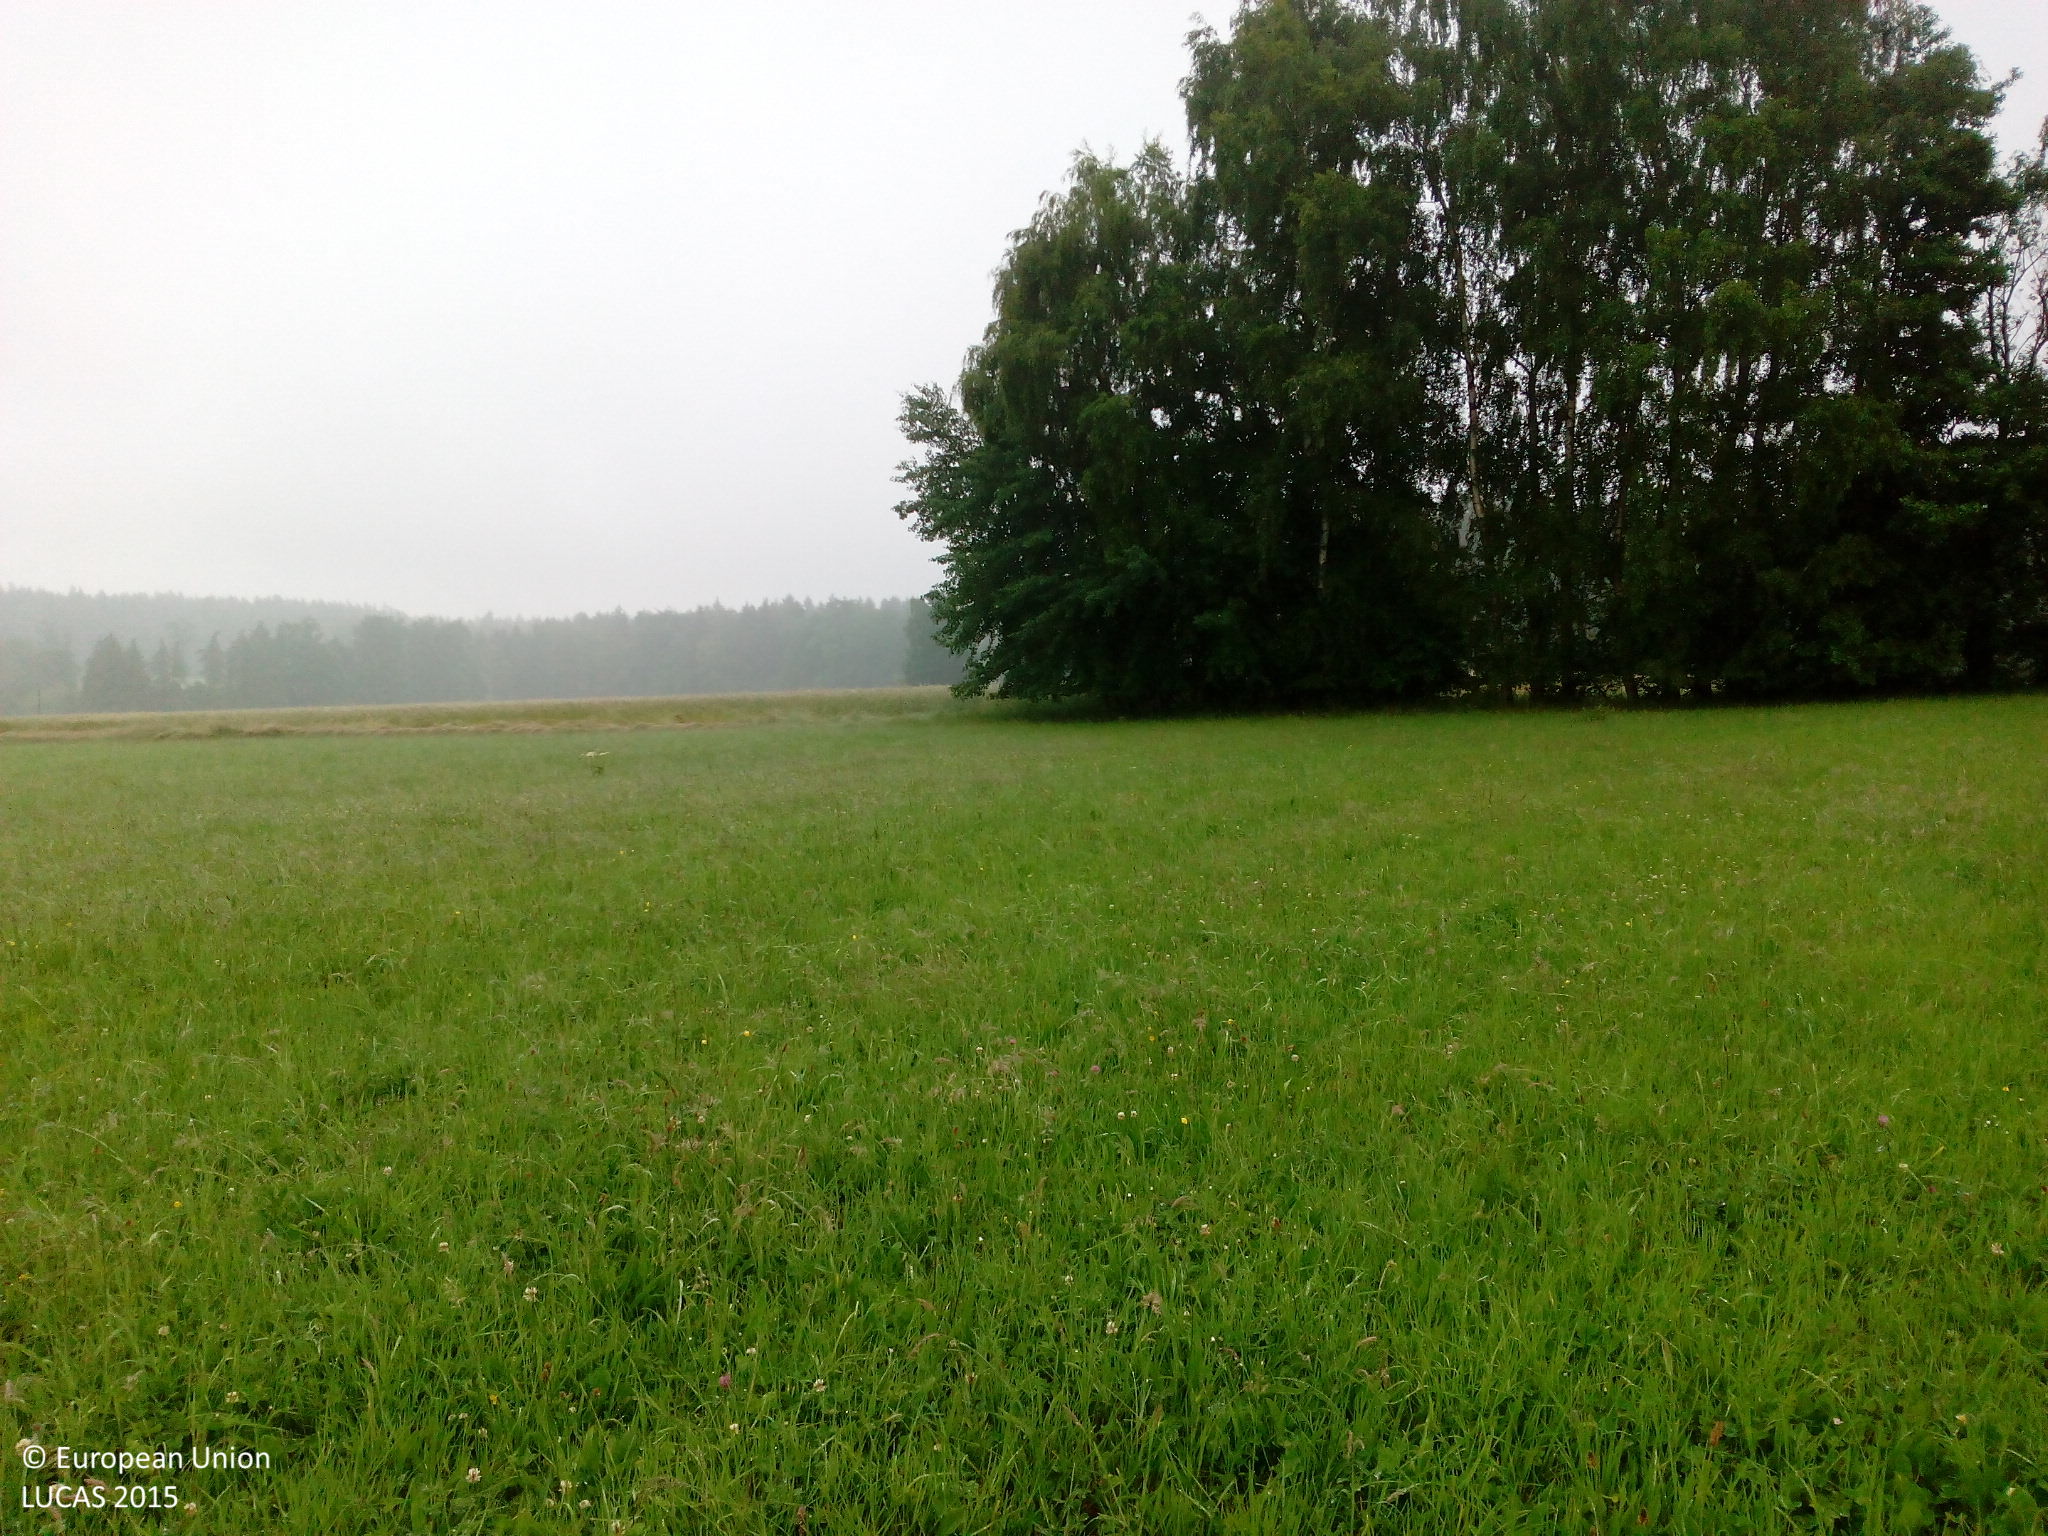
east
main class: Grassland
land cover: Grassland without tree/shrub cover
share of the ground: > 75 %
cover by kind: herbaceous plants 100 %
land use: Agriculture (excluding fallow land and kitchen gardens)
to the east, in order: Grassland without tree/shrub cover; Common wheat; Fences; Grassland without tree/shrub cover; Tracks; Fences; Grassland without tree/shrub cover
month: June
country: DE
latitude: 50.0845
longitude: 11.4950
